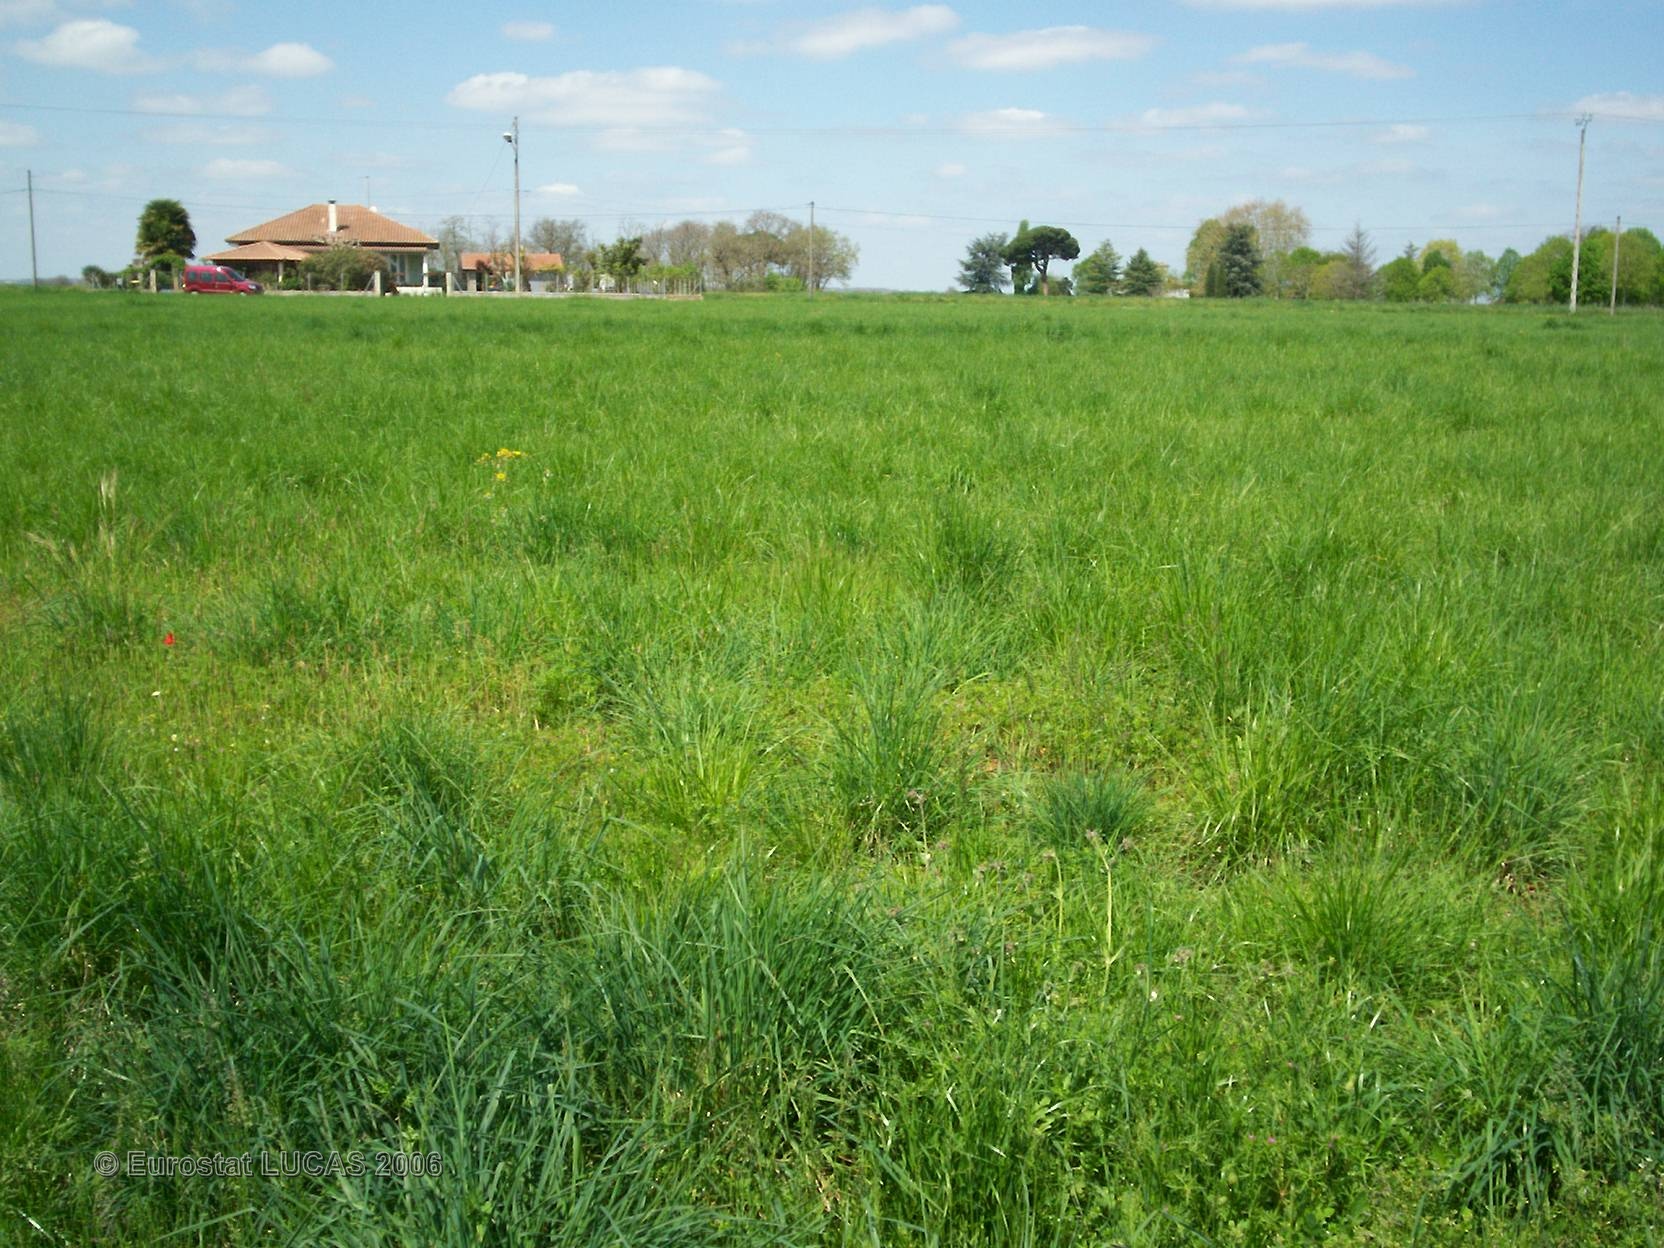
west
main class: Grassland
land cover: Grassland without tree/shrub cover
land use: Agriculture (excluding fallow land and kitchen gardens)
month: April
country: FR
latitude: 43.2861
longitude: 1.1915
